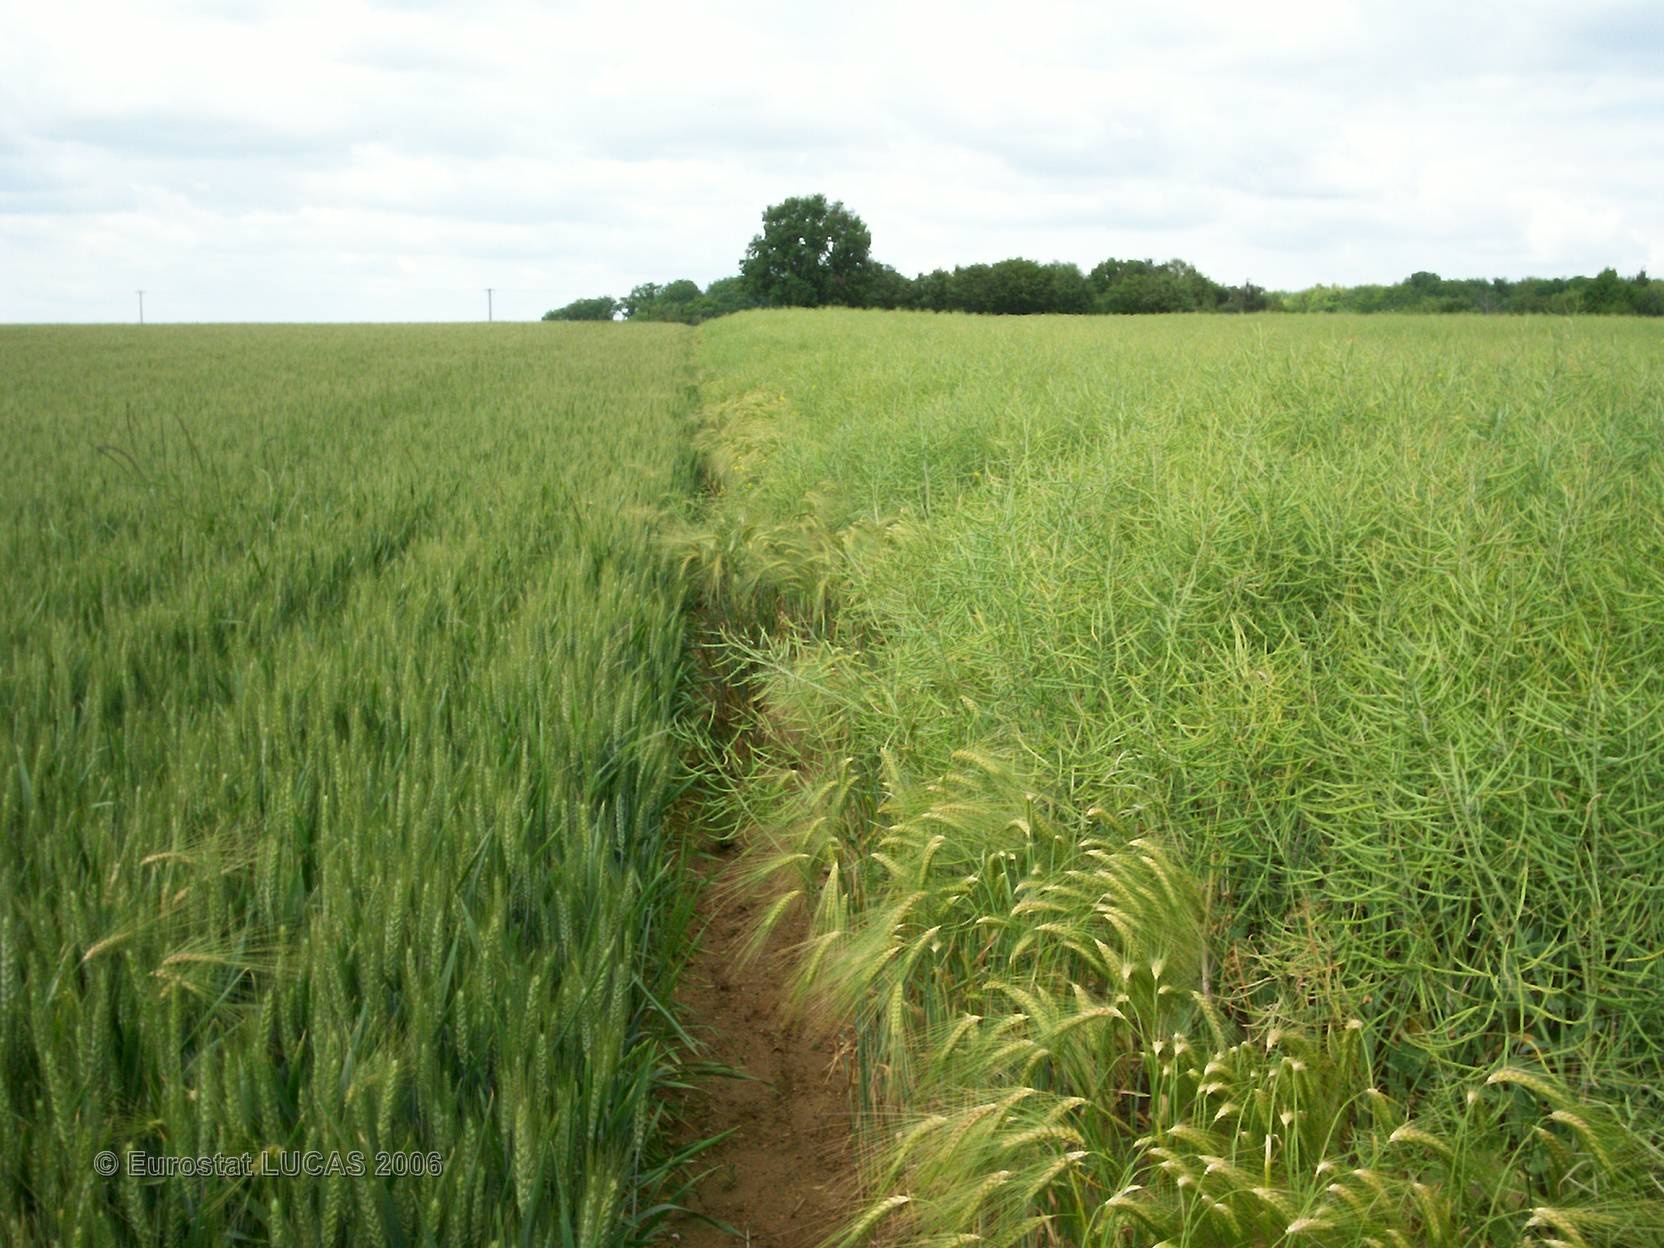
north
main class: Cropland
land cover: Common wheat
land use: Agriculture (excluding fallow land and kitchen gardens)
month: June
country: FR
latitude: 47.0388
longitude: 2.9280
